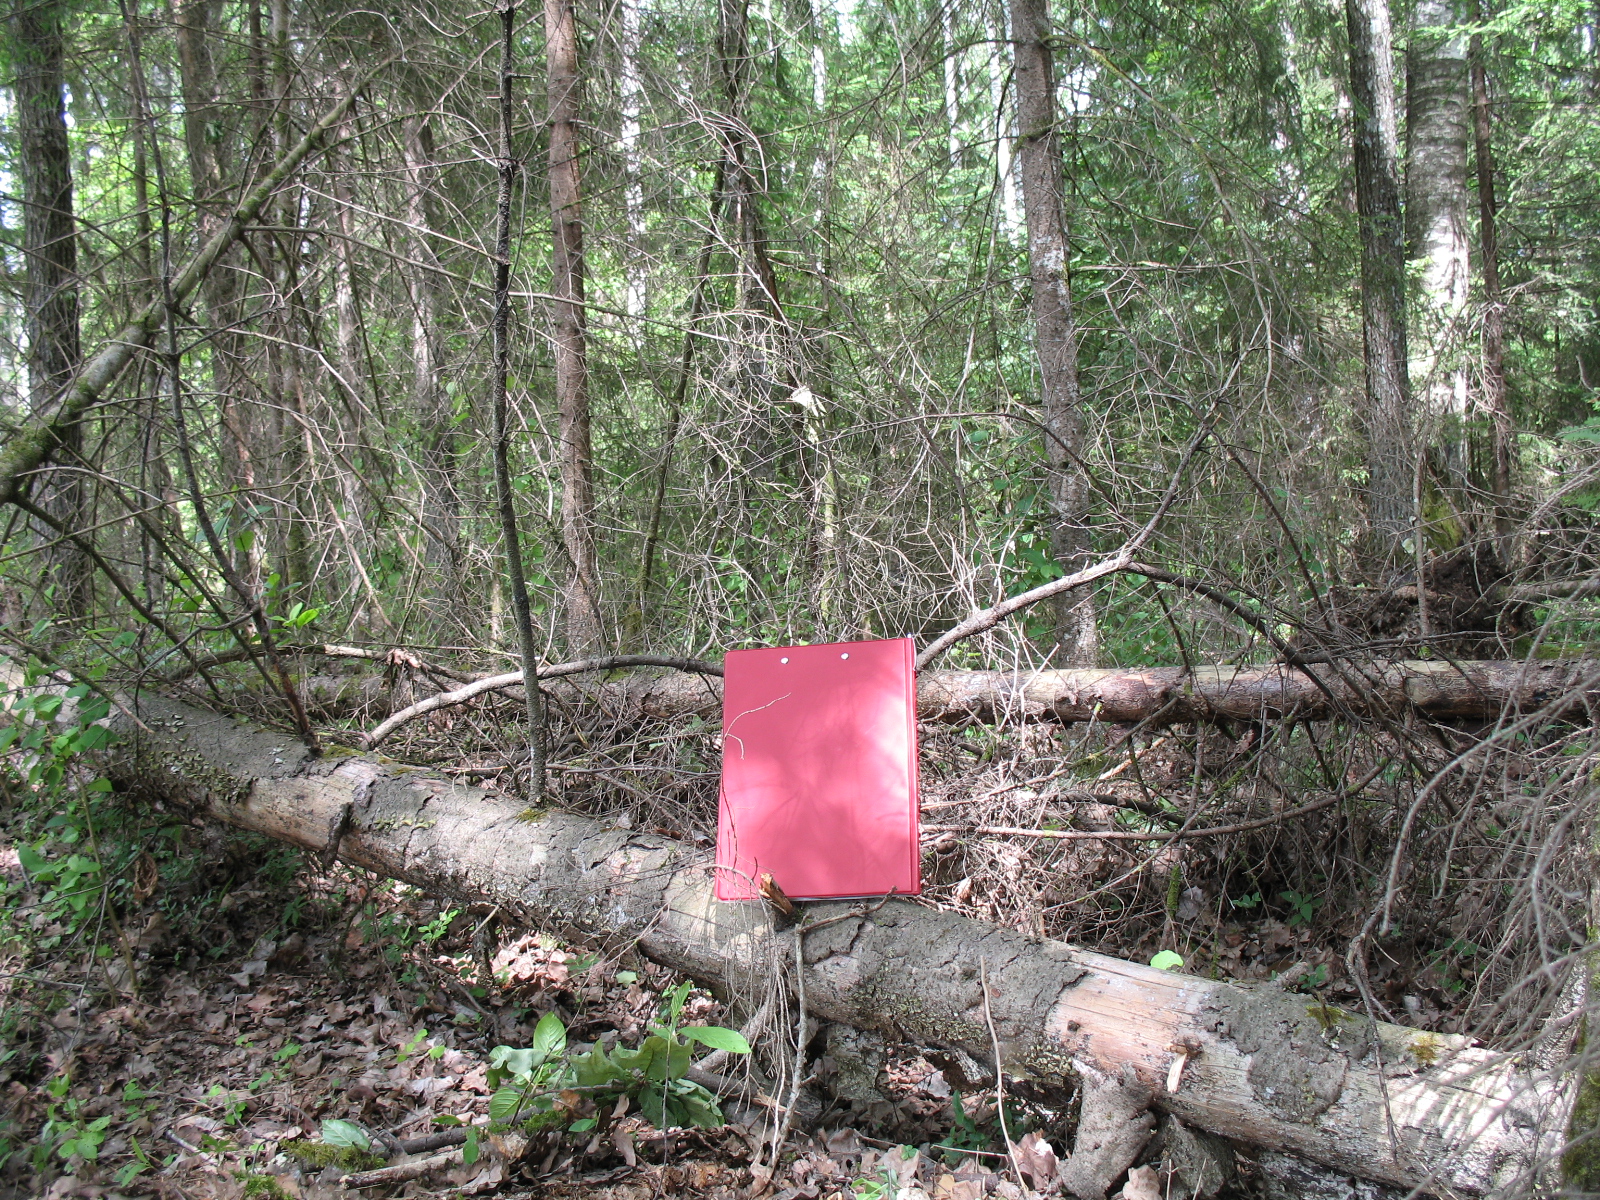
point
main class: Woodland
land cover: Spruce dominated mixed woodland
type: hemiboreal forest and nemoral coniferous forest and mixed broadleaved-coniferous forest
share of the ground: > 75 %
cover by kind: broadleaved forest trees 60 %, coniferous forest trees 35 %, shrubs 5 %
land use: Forestry
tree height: > 5 m
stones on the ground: < 10 %
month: June
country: LV
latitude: 56.6746
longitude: 23.5062
